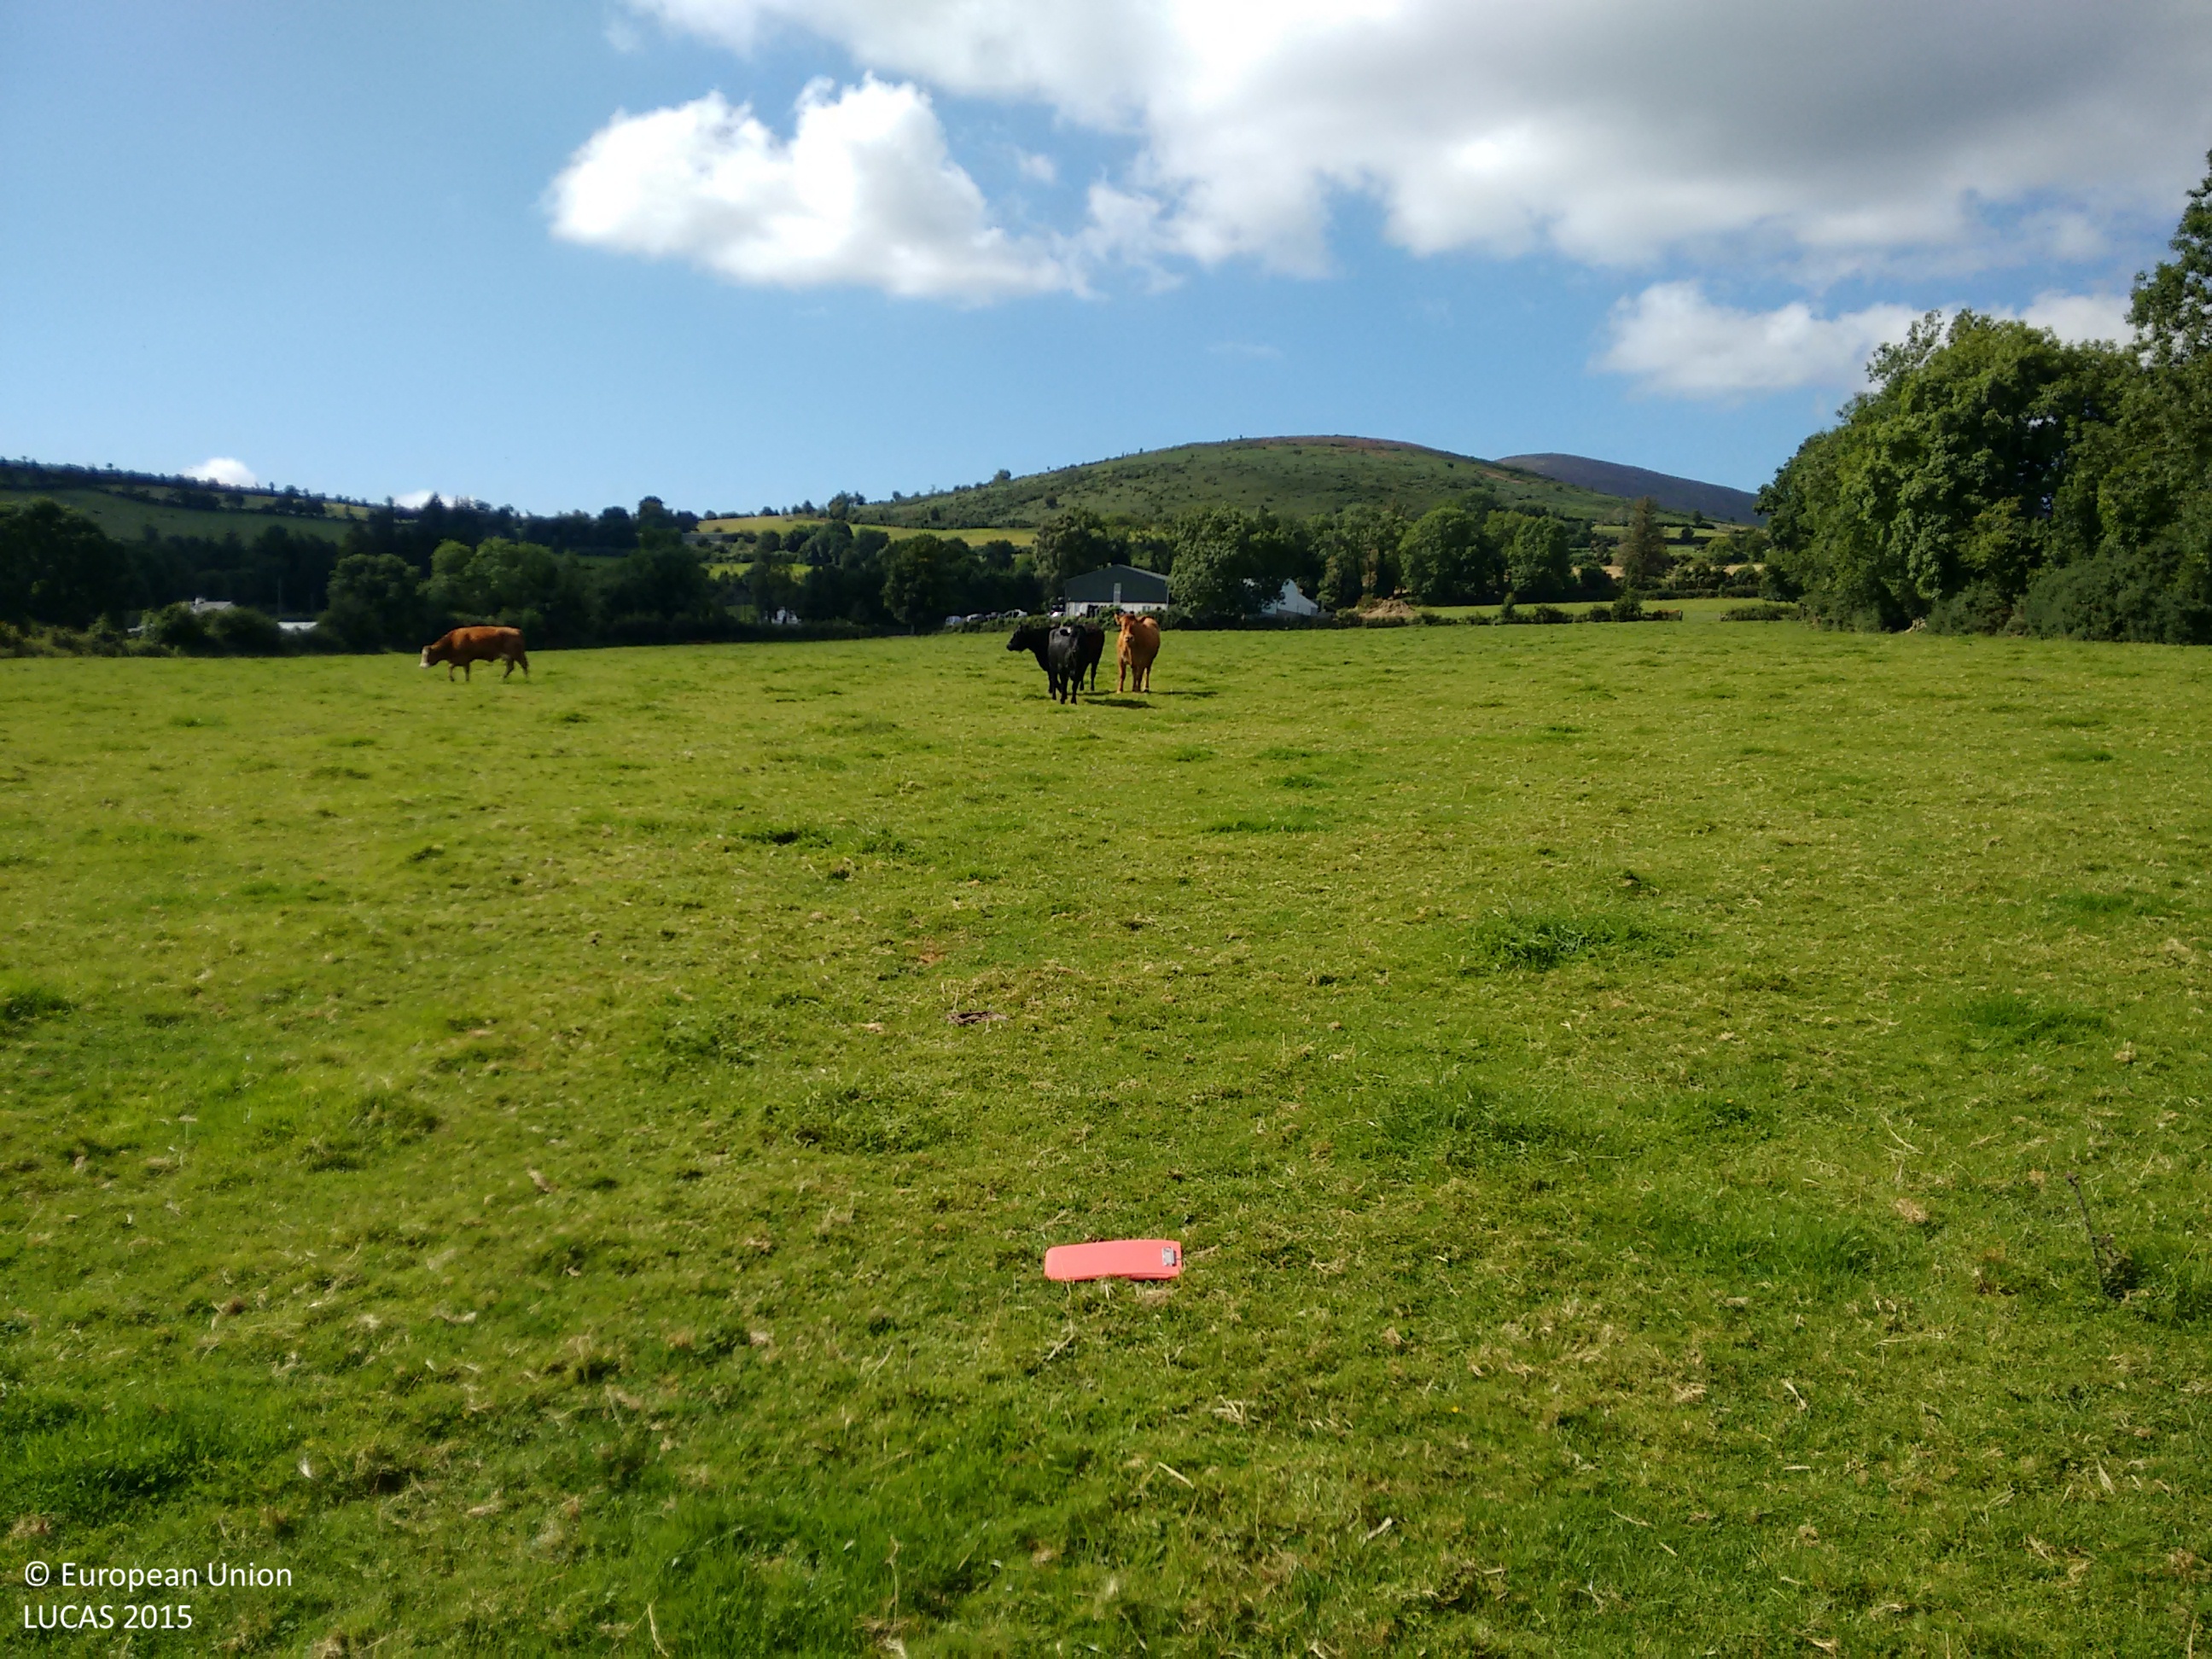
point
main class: Grassland
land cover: Grassland without tree/shrub cover
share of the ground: > 75 %
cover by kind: herbaceous plants 100 %
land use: Agriculture (excluding fallow land and kitchen gardens)
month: August
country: IE
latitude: 52.6349
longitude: -6.6976
